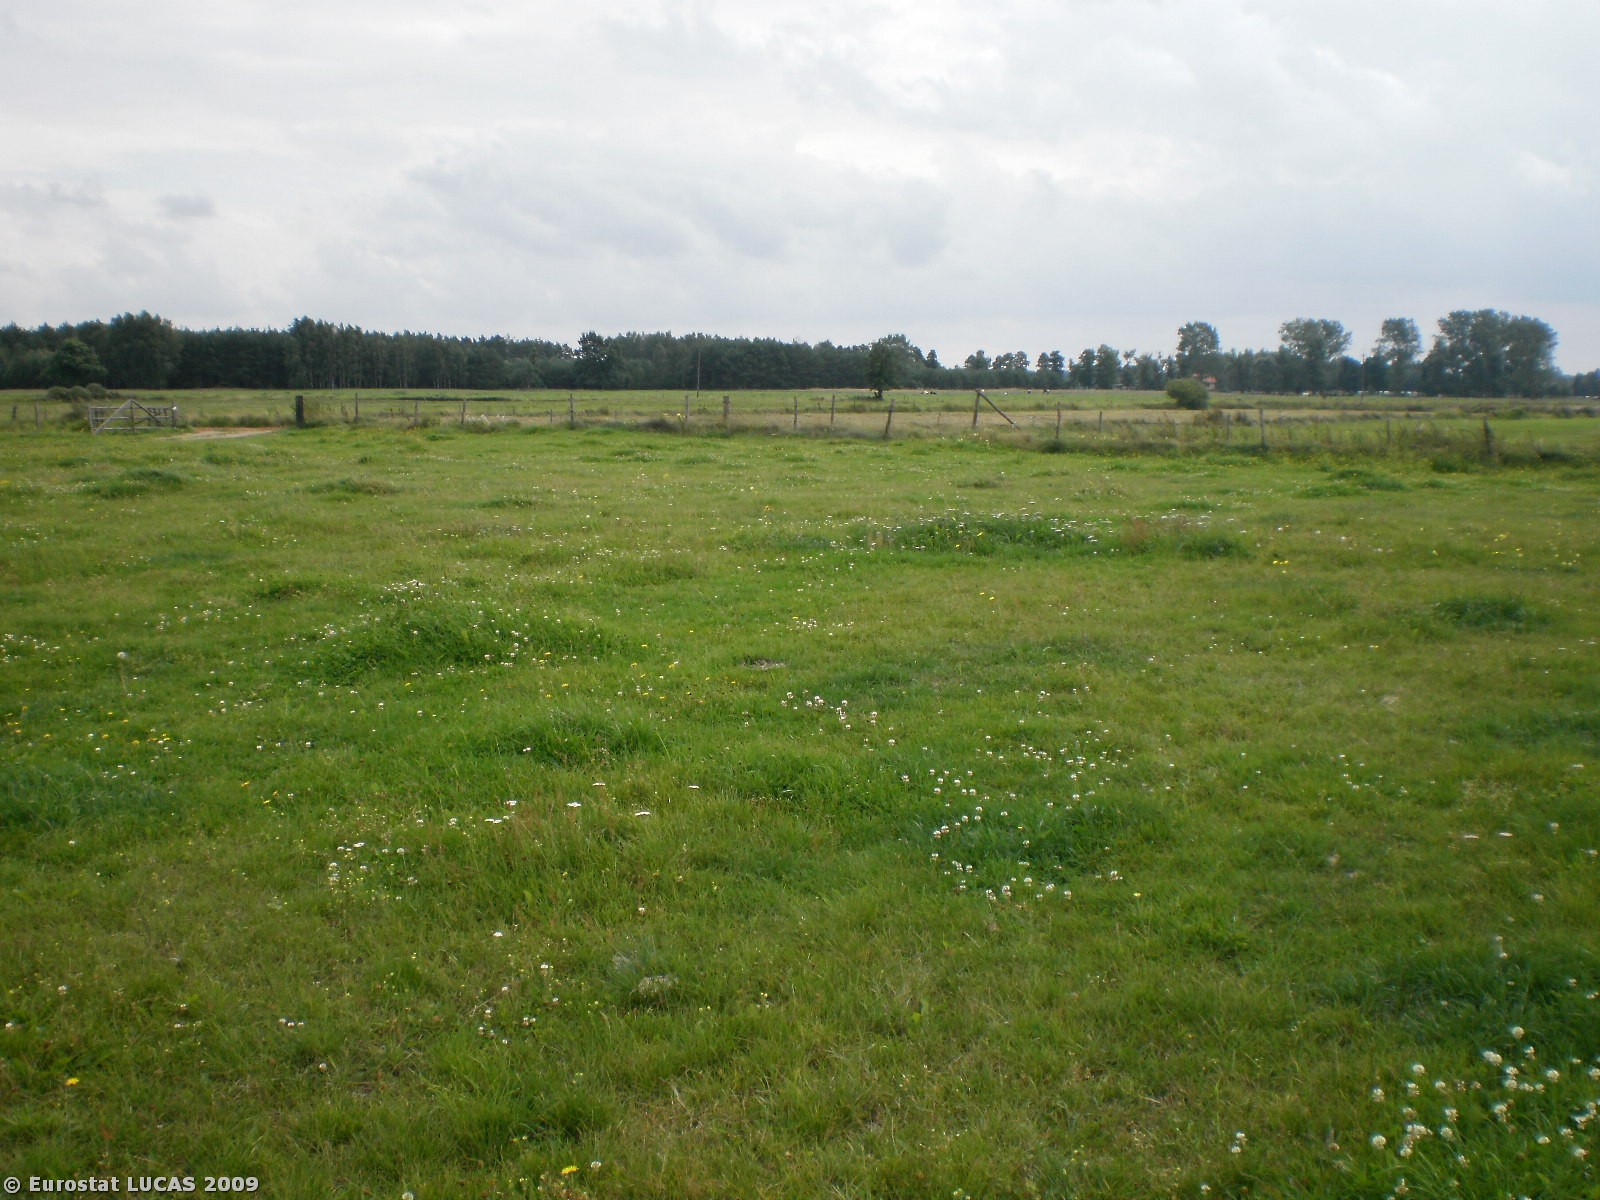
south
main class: Grassland
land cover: Grassland without tree/shrub cover
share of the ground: > 75 %
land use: Agriculture (excluding fallow land and kitchen gardens)
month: August
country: PL
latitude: 53.2469
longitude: 20.9682
